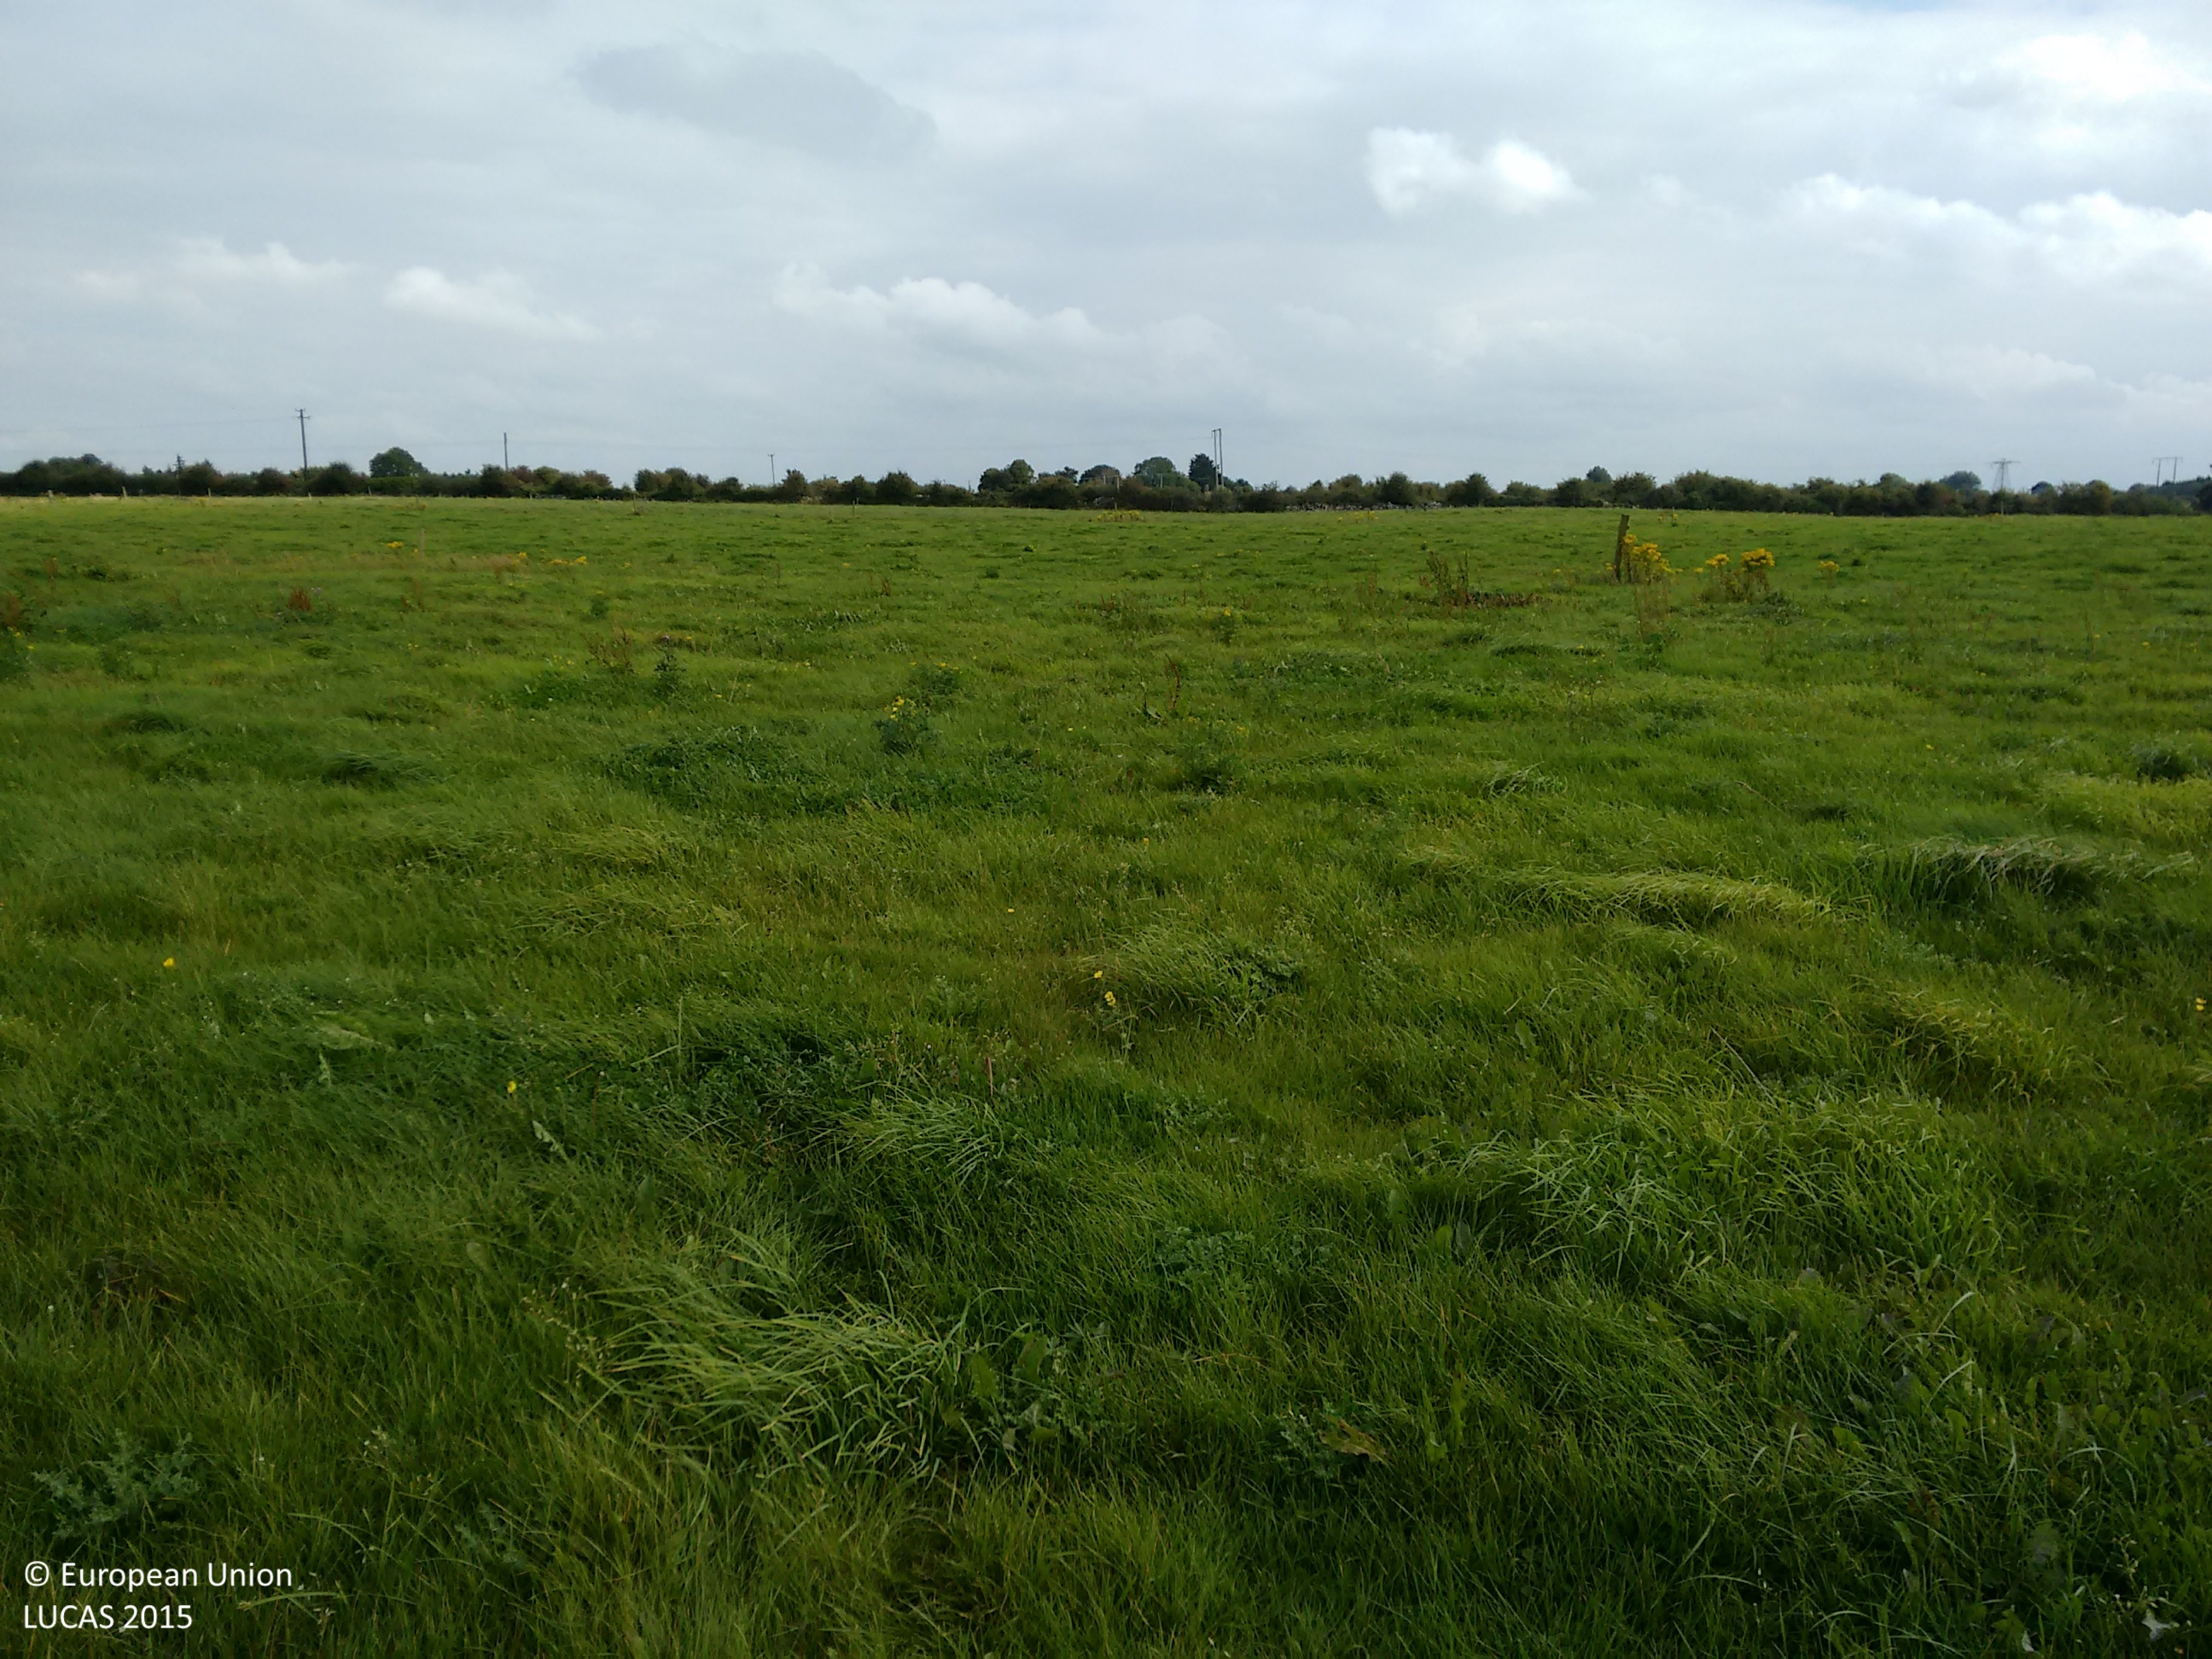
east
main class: Grassland
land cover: Grassland without tree/shrub cover
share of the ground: > 75 %
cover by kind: herbaceous plants 100 %
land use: Agriculture (excluding fallow land and kitchen gardens)
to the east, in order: Grassland without tree/shrub cover; Fences; Grassland without tree/shrub cover; Fences; Grassland without tree/shrub cover; Fences; Dry stone walls; Abandoned hedges; Grassland without tree/shrub cover
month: September
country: IE
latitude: 52.6095
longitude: -9.0433
